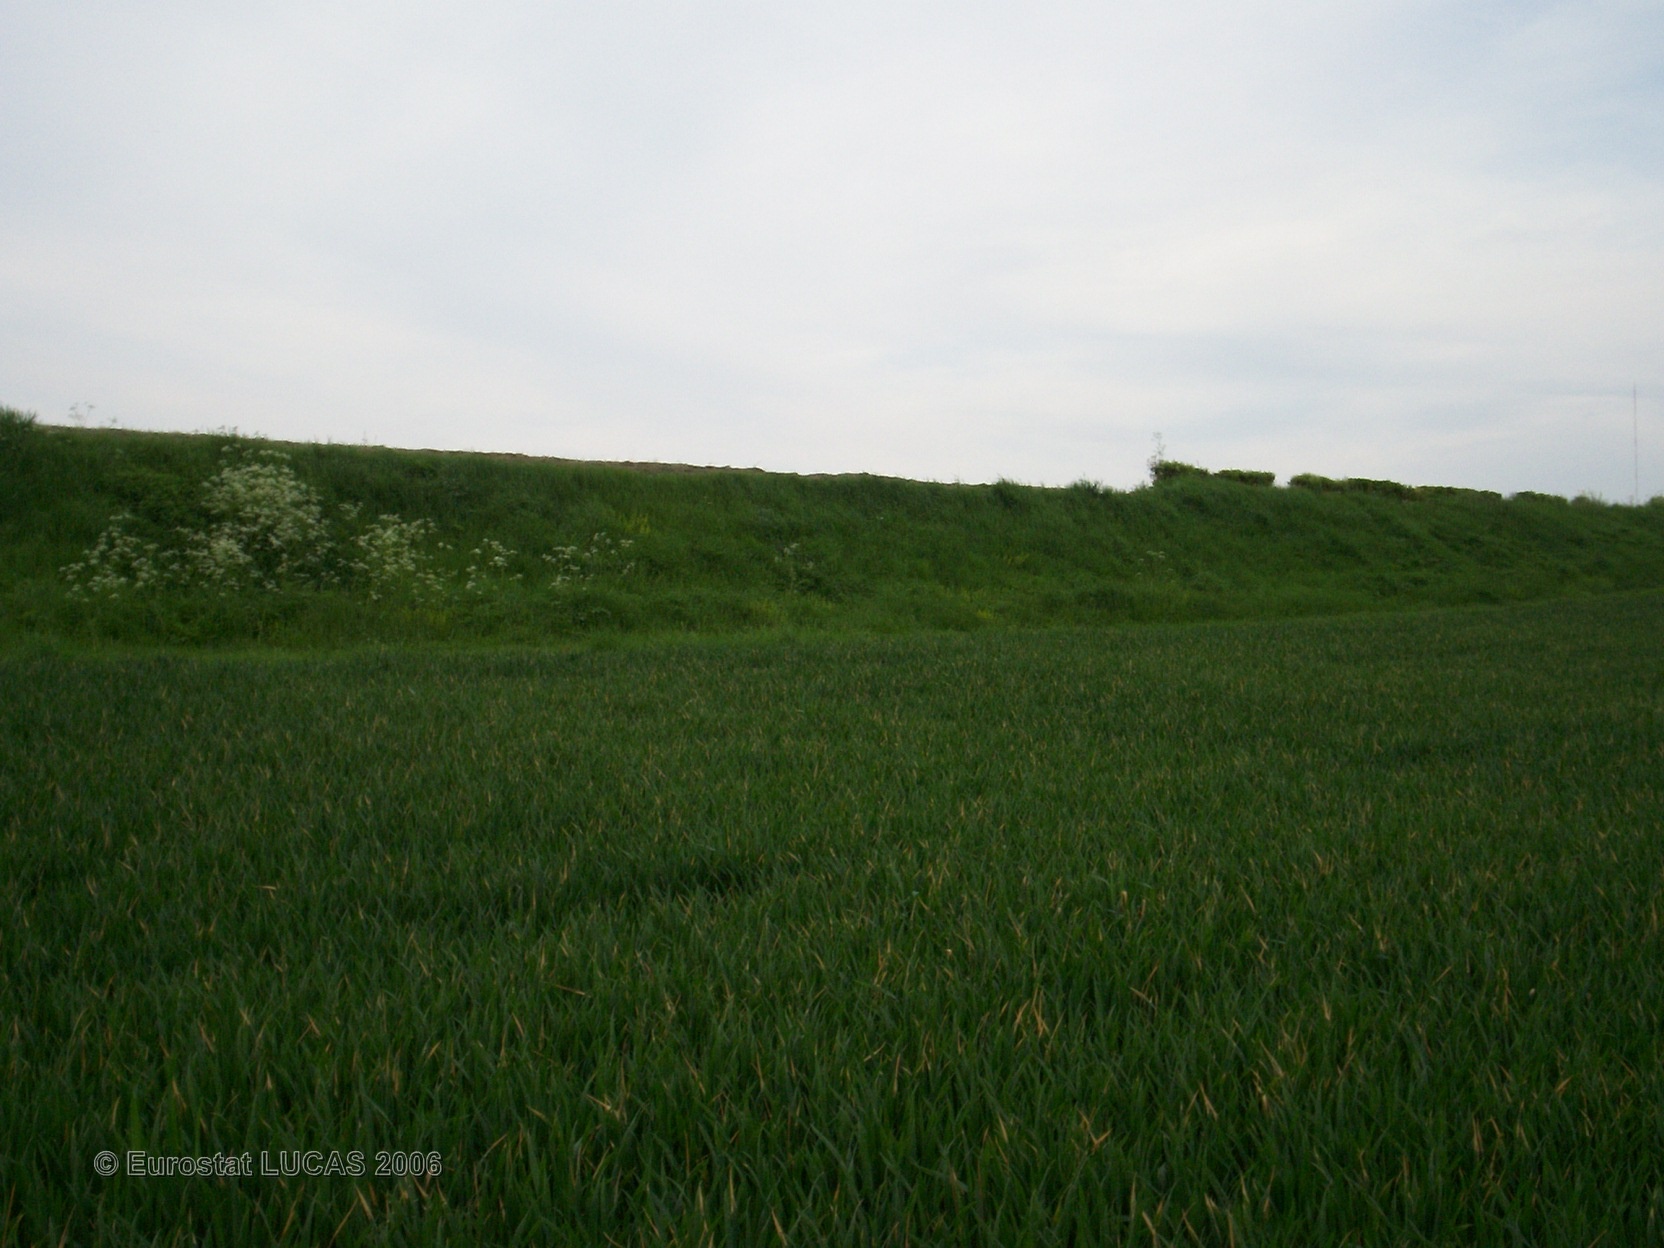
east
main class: Cropland
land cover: Common wheat
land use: Agriculture (excluding fallow land and kitchen gardens)
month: May
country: FR
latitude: 49.5377
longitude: 4.3162
